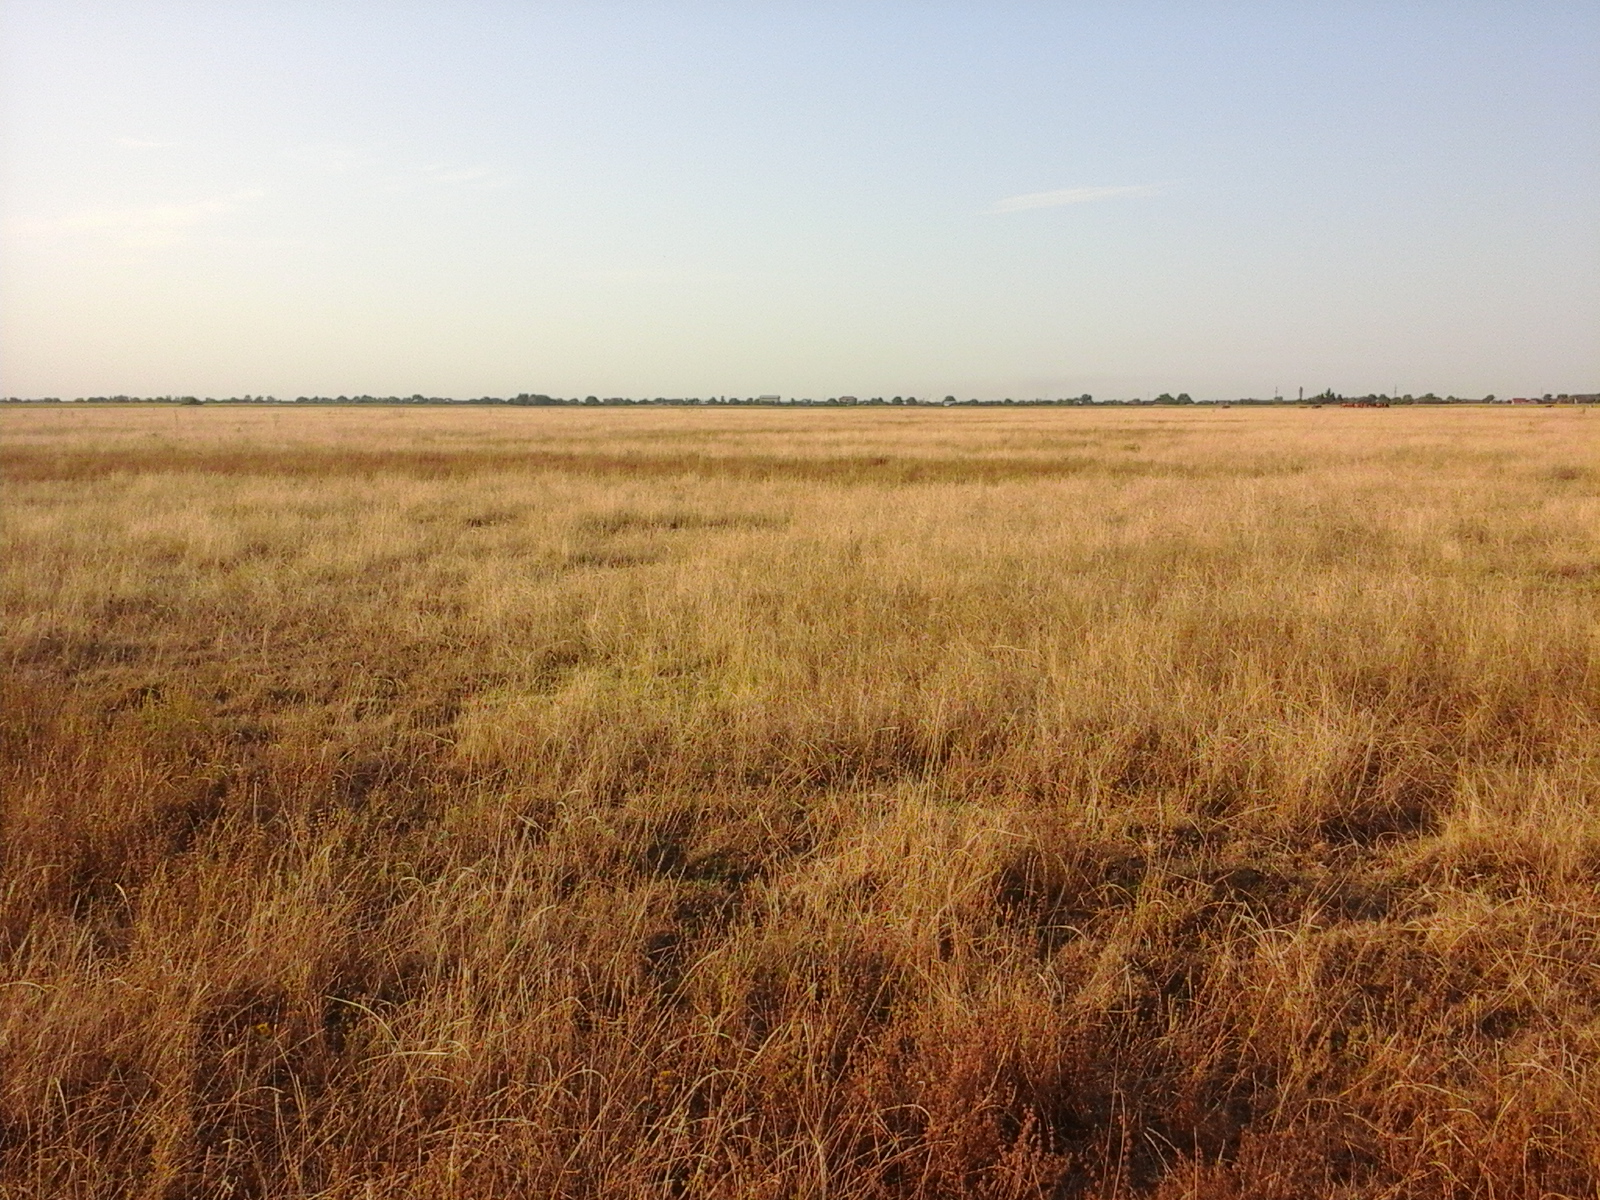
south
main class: Grassland
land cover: Grassland without tree/shrub cover
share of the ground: > 75 %
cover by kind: herbaceous plants 100 %
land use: Agriculture (excluding fallow land and kitchen gardens)
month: August
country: RO
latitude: 44.1792
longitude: 23.7517
